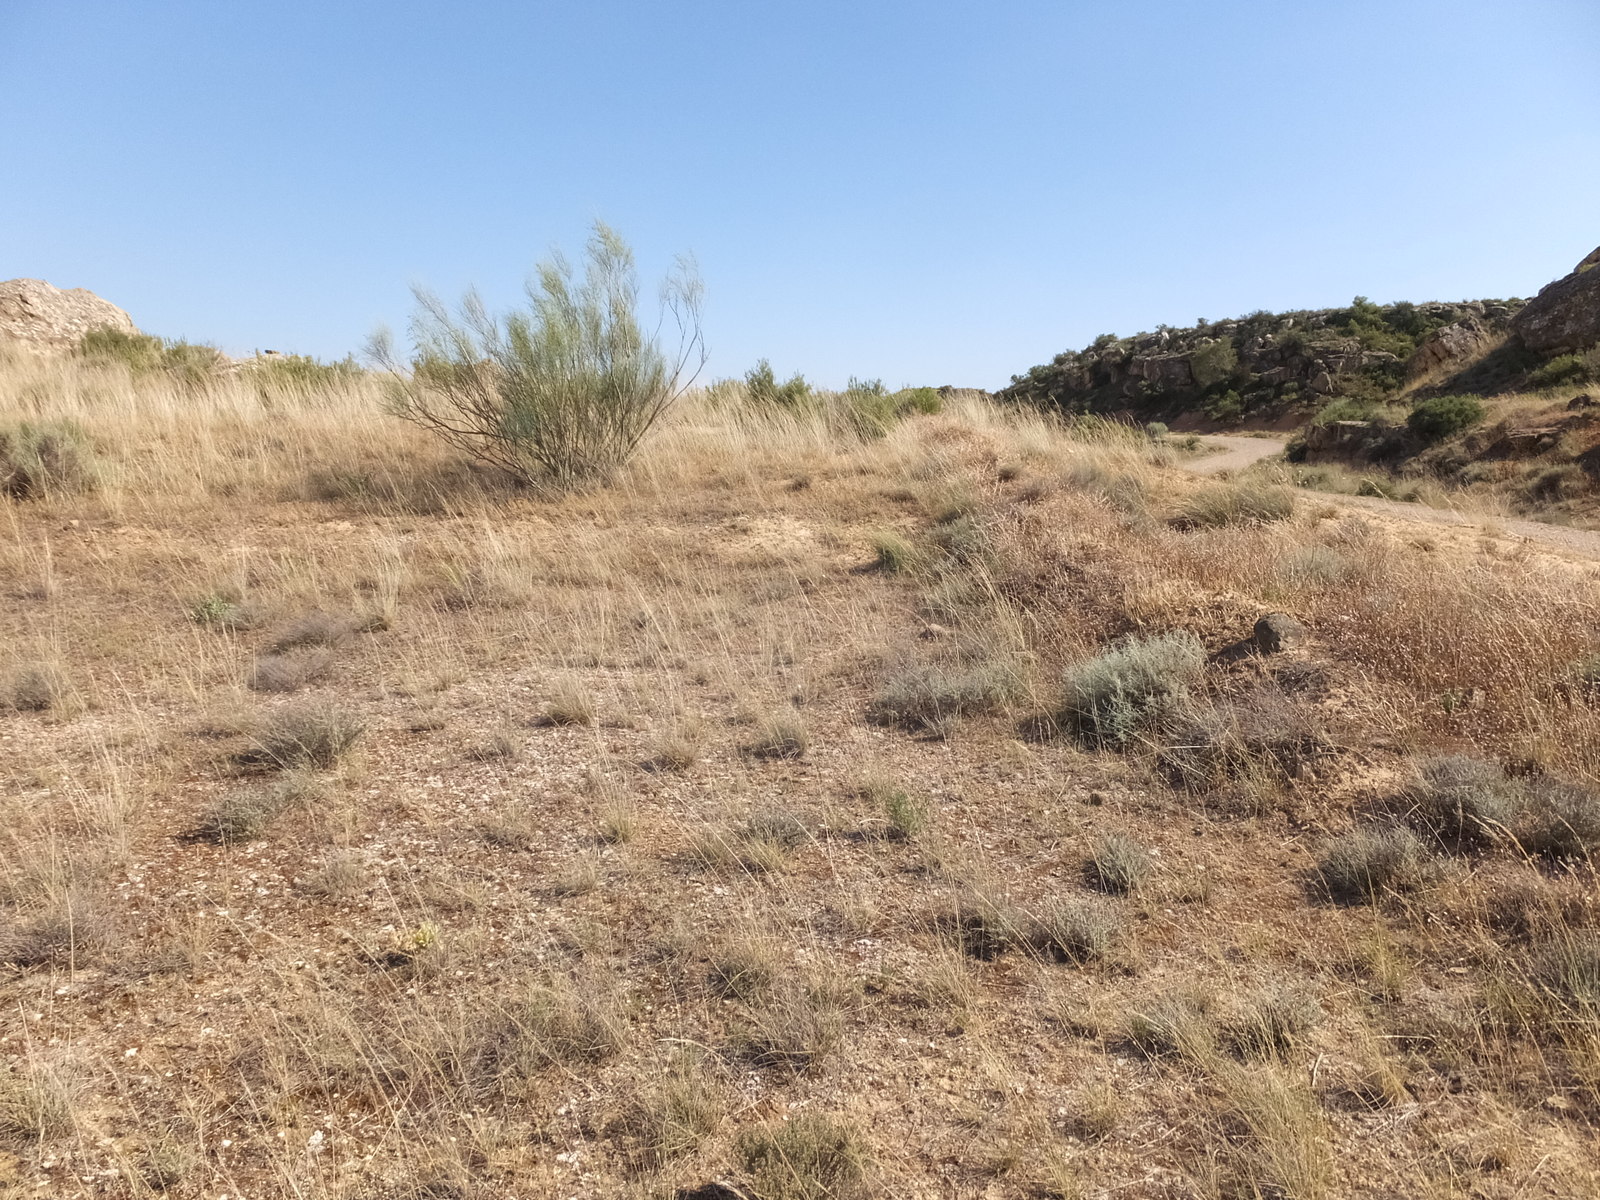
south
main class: Grassland
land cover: Grassland without tree/shrub cover
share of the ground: > 75 %
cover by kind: herbaceous plants 50 %, consolidated bare surface 50 %
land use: Semi-natural and natural areas not in use
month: June
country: ES
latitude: 41.2445
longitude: -0.2161
